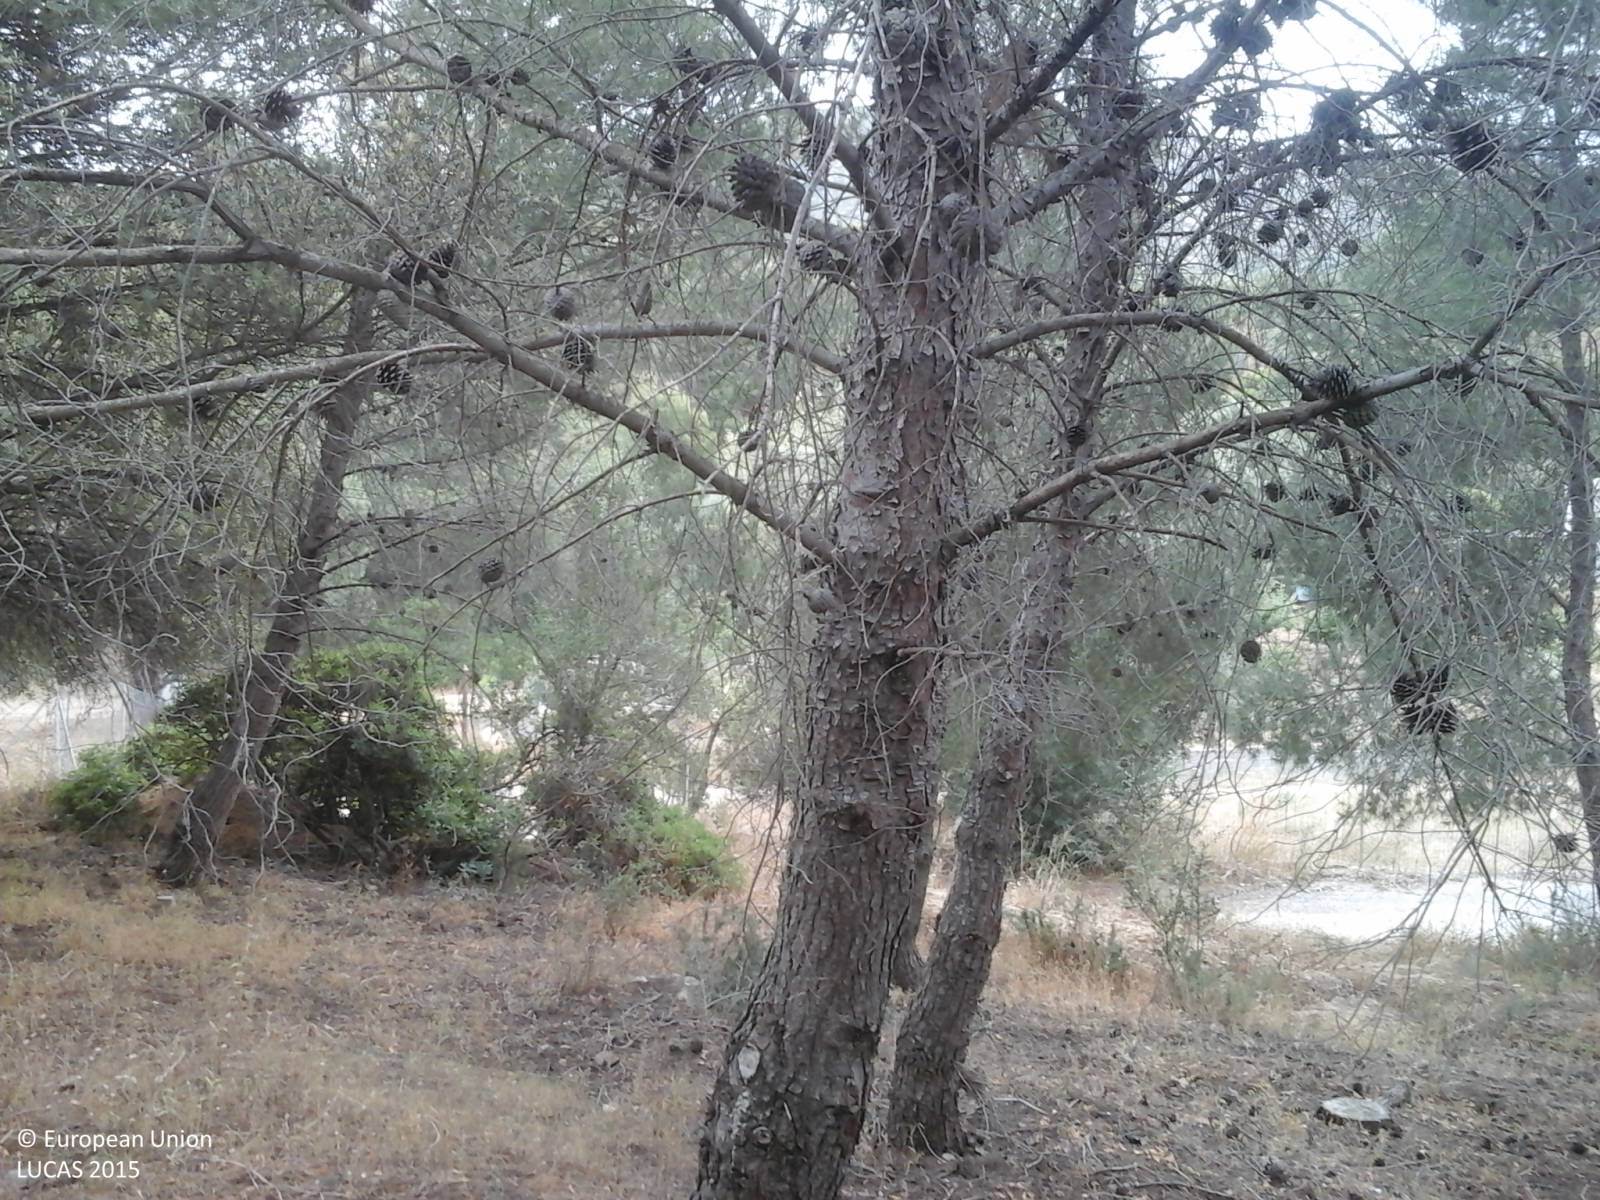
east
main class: Woodland
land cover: Pine dominated coniferous woodland
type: coniferous forest of the mediterranean region
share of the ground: > 75 %
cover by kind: coniferous forest trees 50 %, shrubs 30 %, broadleaved forest trees 10 %, herbaceous plants 10 %
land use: Semi-natural and natural areas not in use
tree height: > 5 m
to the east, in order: Pine dominated coniferous woodland; Tracks; Pine dominated coniferous woodland
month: May
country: IT
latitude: 39.1965
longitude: 9.3441
